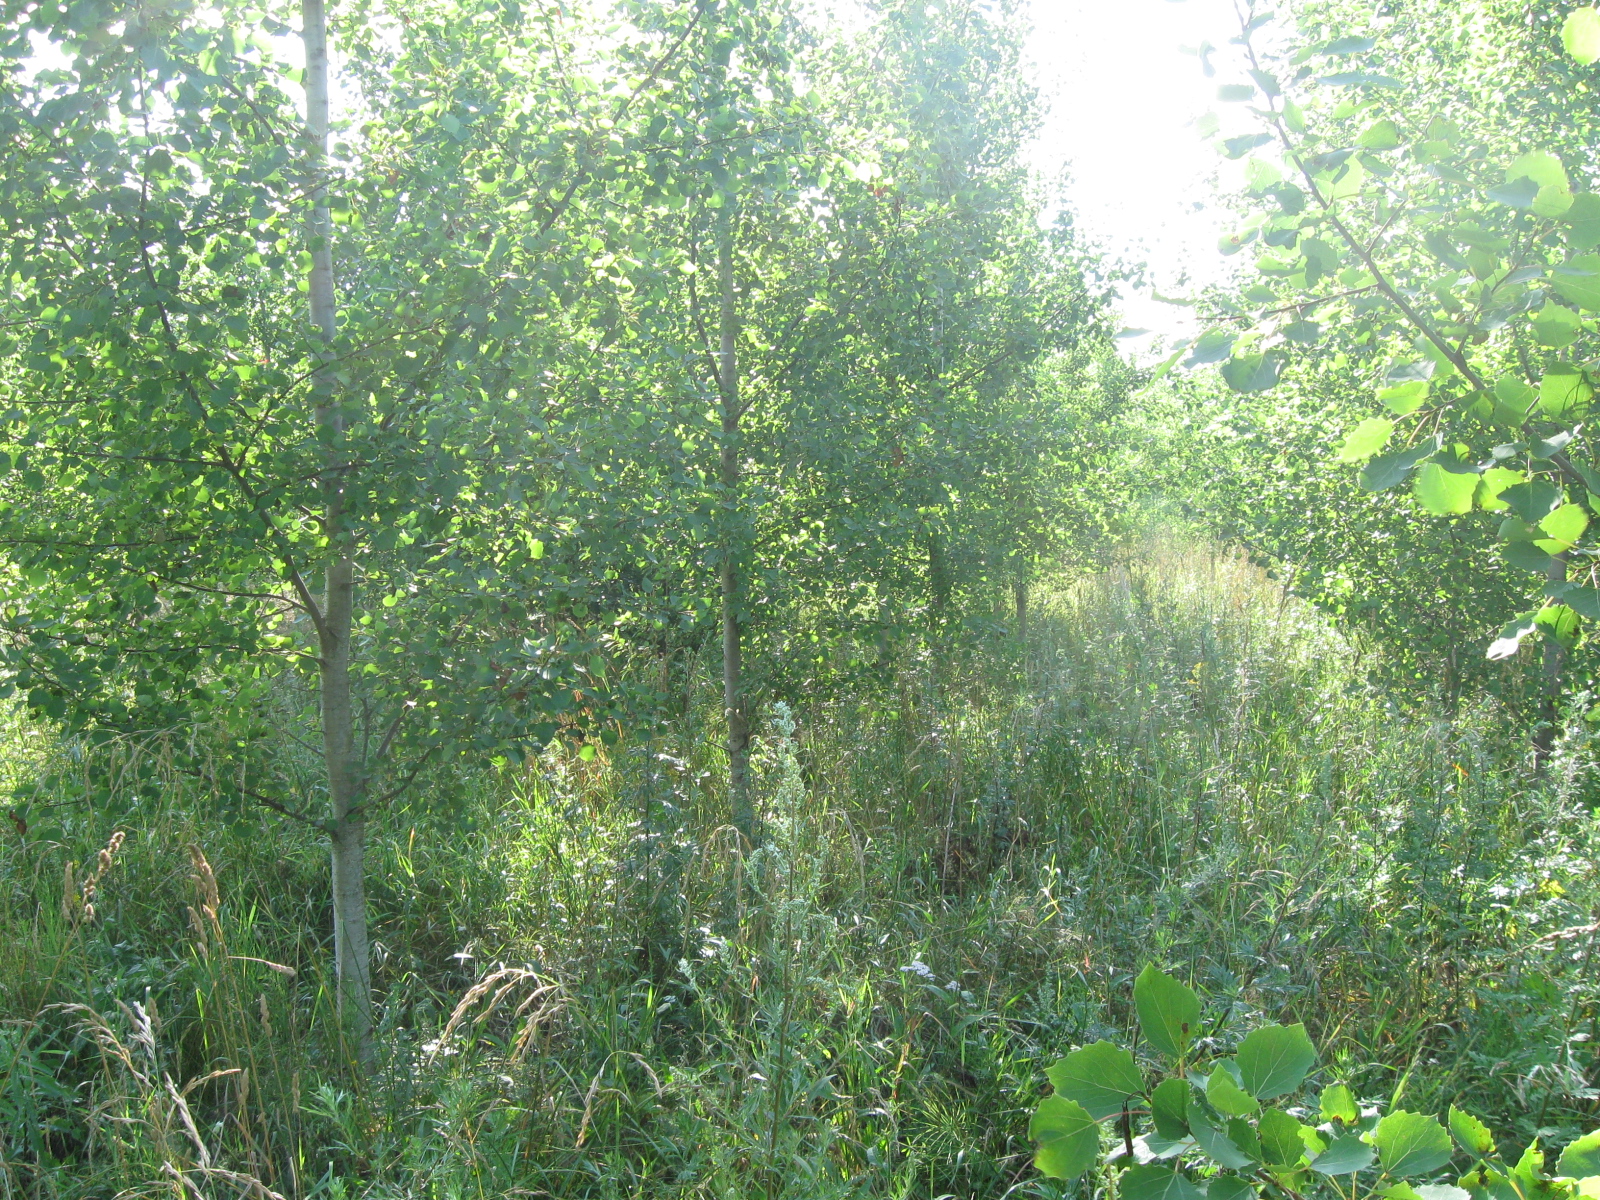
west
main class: Woodland
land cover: Broadleaved woodland
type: non-riverine alder, birch or aspen forest
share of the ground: 50 - 75 %
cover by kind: broadleaved forest trees 55 %, herbaceous plants 45 %
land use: Forestry
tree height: < 5 m
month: July
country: LT
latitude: 54.3053
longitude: 23.4675
